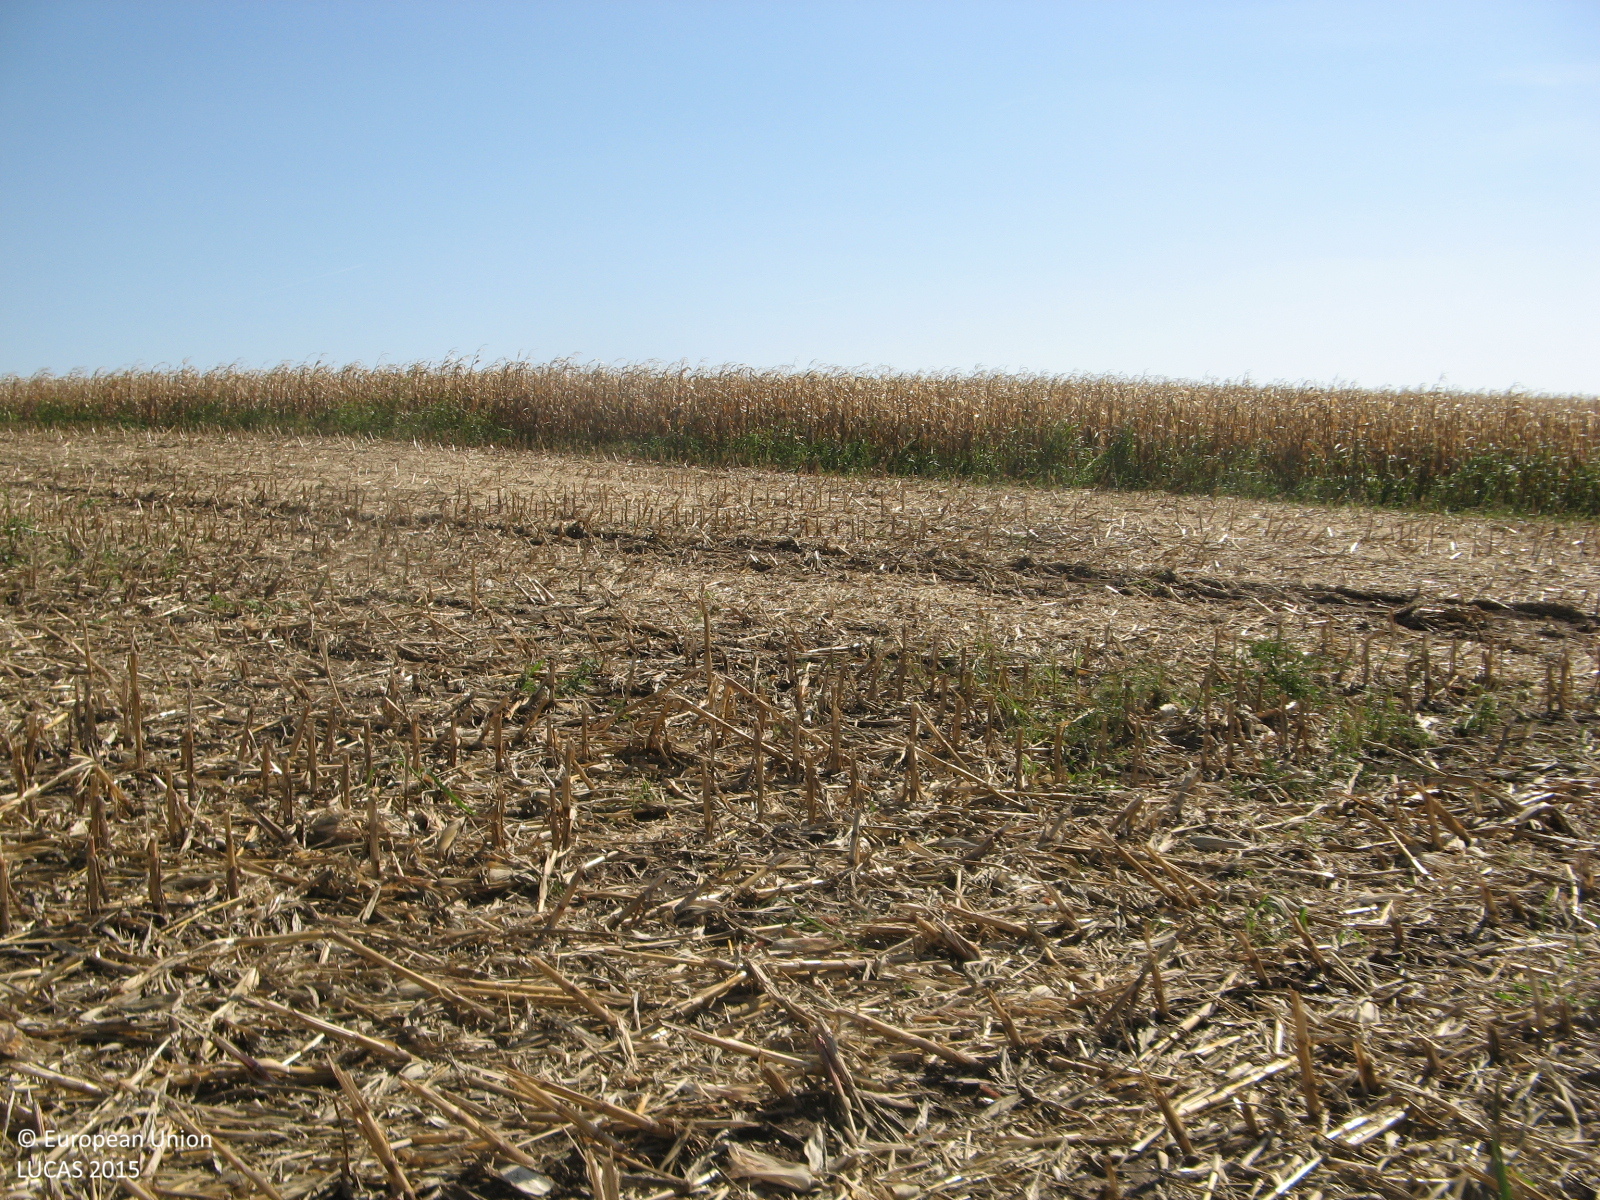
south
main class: Cropland
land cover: Maize
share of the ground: 10 - 25 %
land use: Agriculture (excluding fallow land and kitchen gardens)
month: September
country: BG
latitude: 43.5686
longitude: 25.6997
